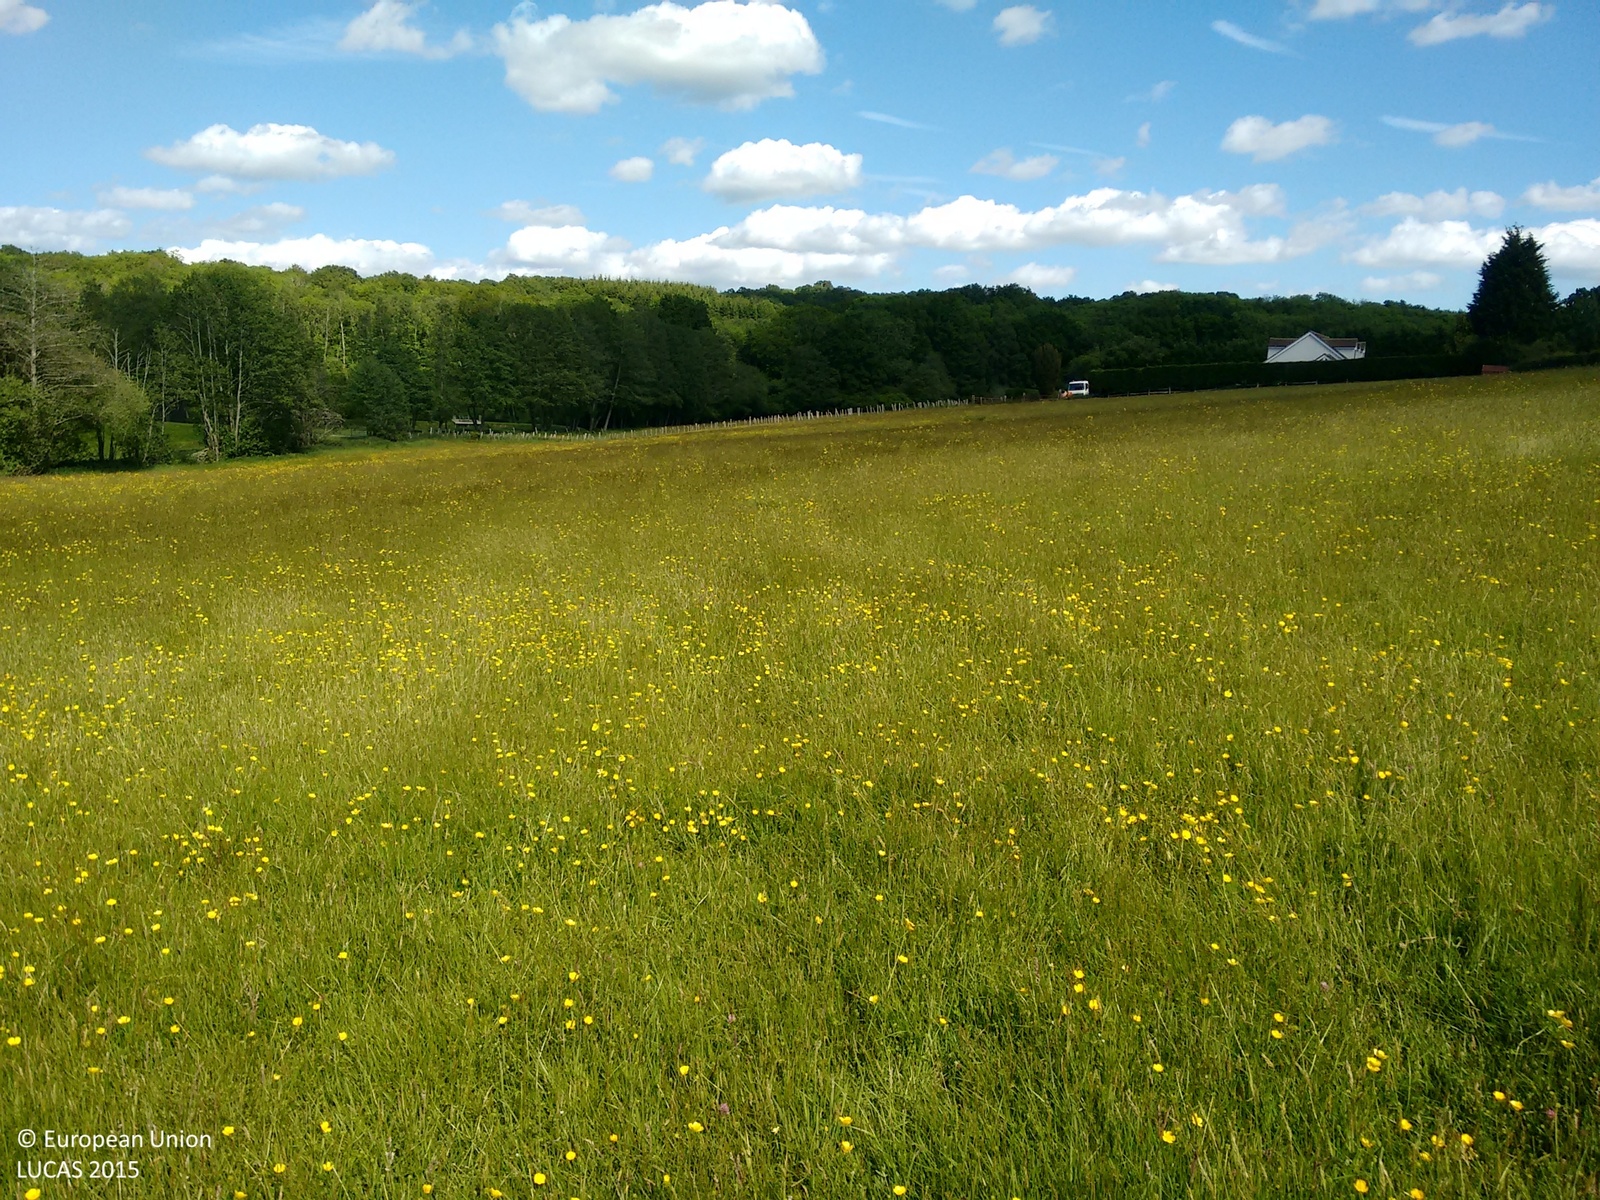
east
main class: Grassland
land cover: Grassland without tree/shrub cover
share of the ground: > 75 %
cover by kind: herbaceous plants 100 %
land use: Agriculture (excluding fallow land and kitchen gardens)
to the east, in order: Grassland without tree/shrub cover; Fences; Grass margins; Tracks; Grass margins; Fences; Grassland without tree/shrub cover
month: June
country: GB
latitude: 50.9733
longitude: 0.6166
